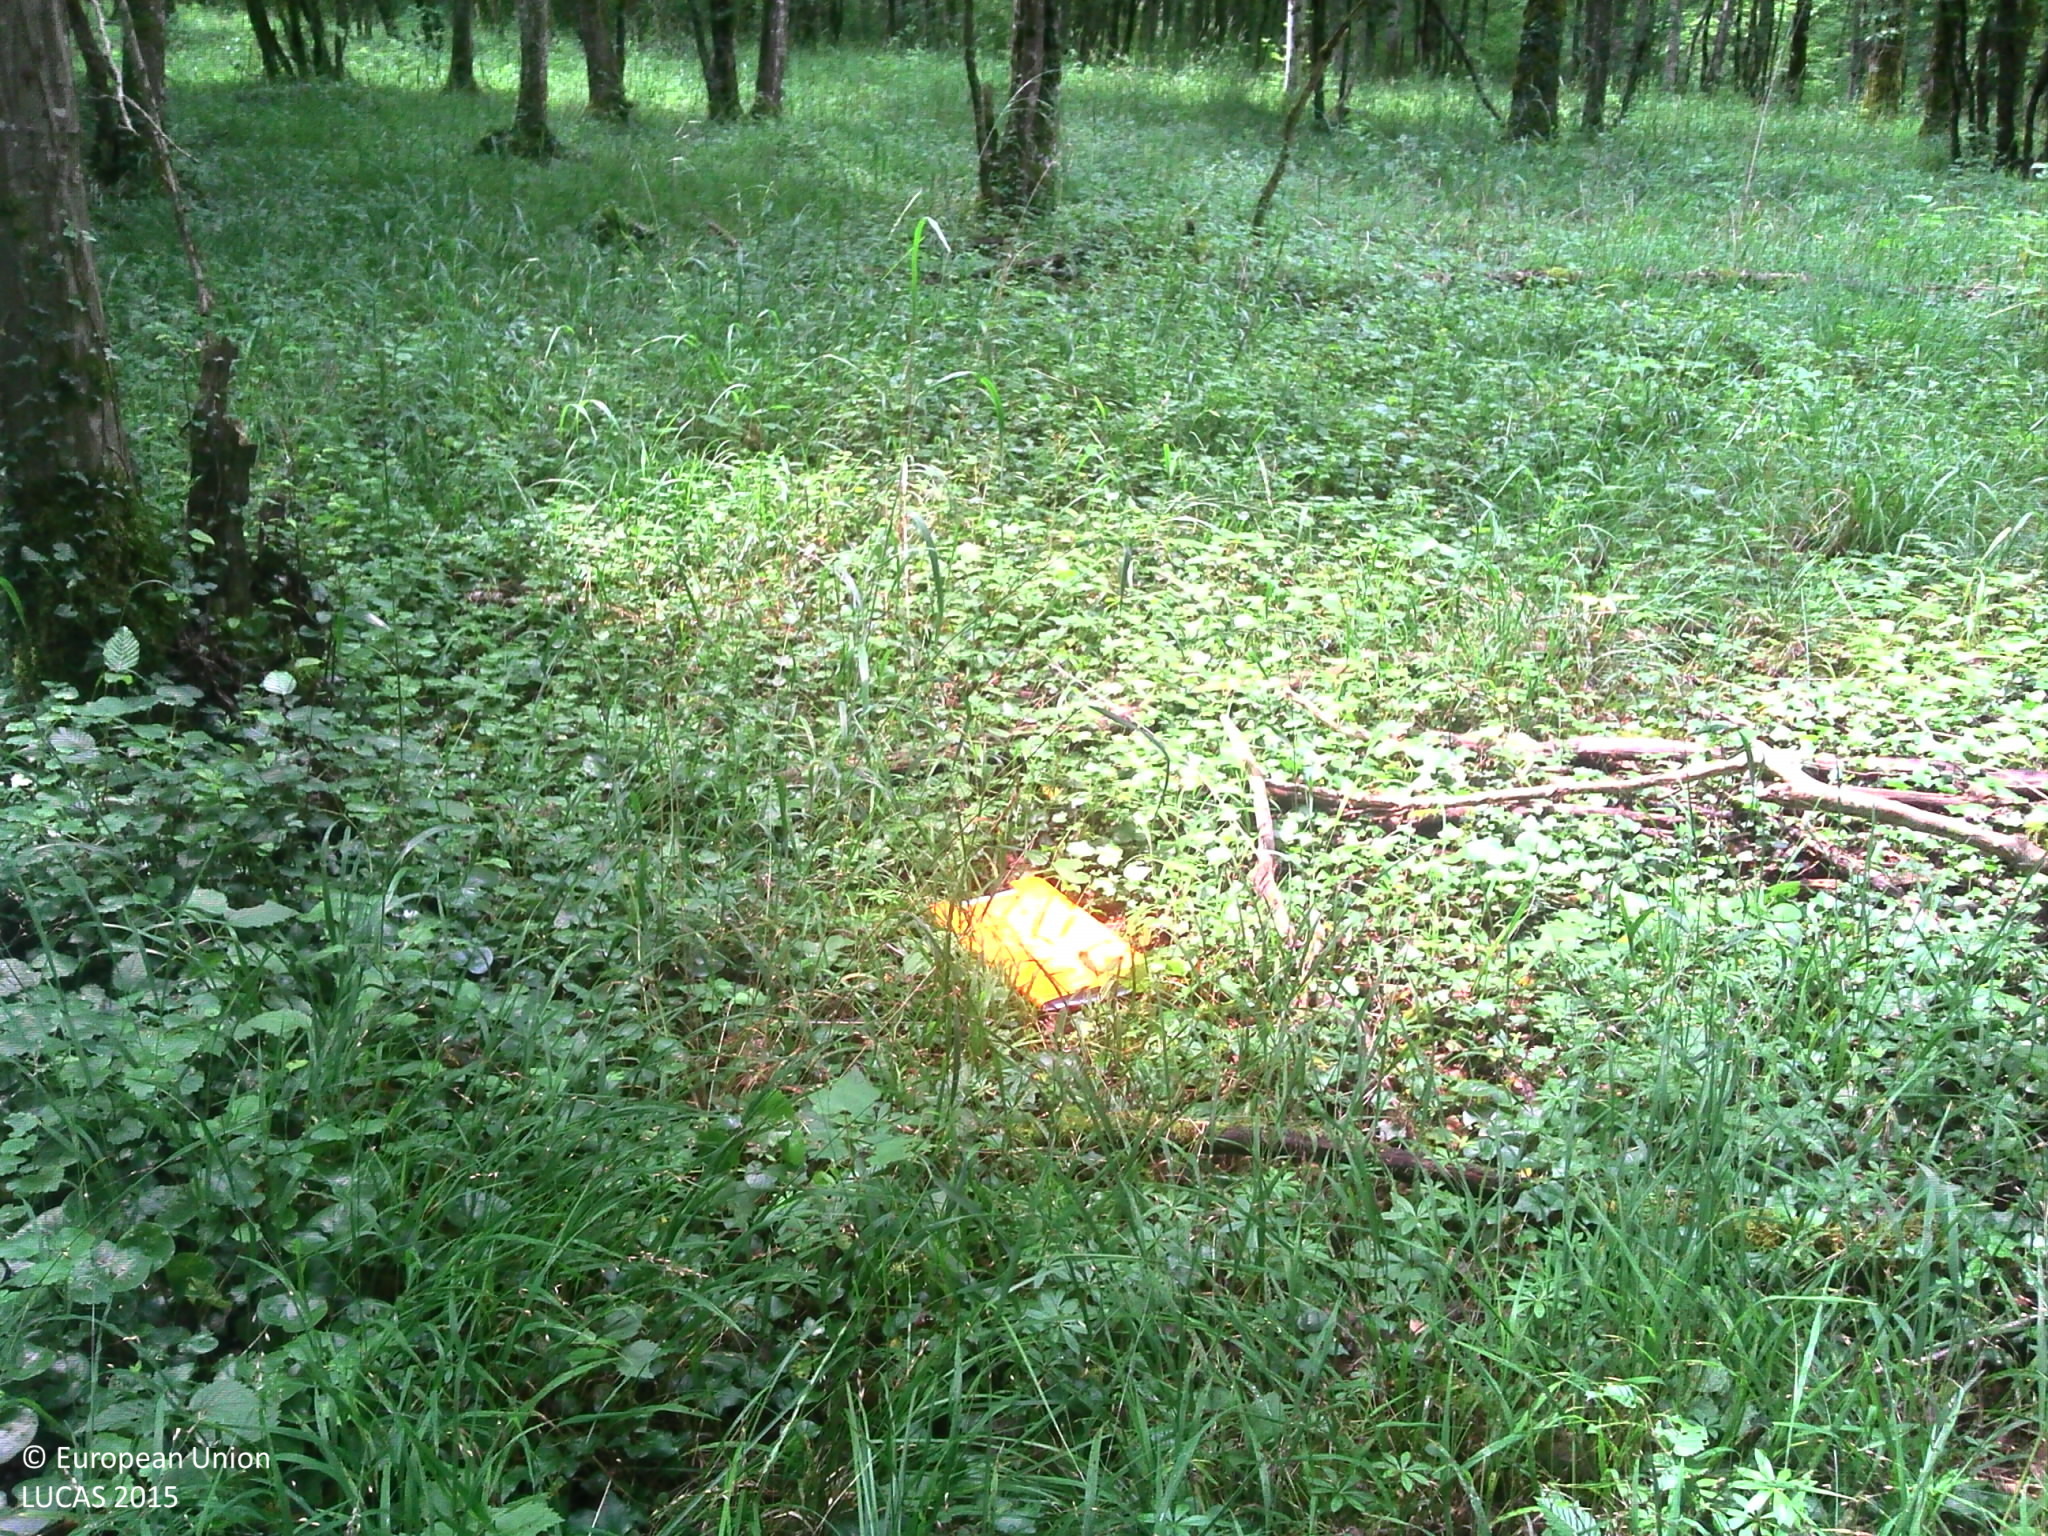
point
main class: Woodland
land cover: Broadleaved woodland
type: mesophytic deciduous forest
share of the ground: > 75 %
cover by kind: broadleaved forest trees 80 %, herbaceous plants 20 %
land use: Forestry
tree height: > 5 m
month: June
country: FR
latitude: 48.2377
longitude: 5.0305
